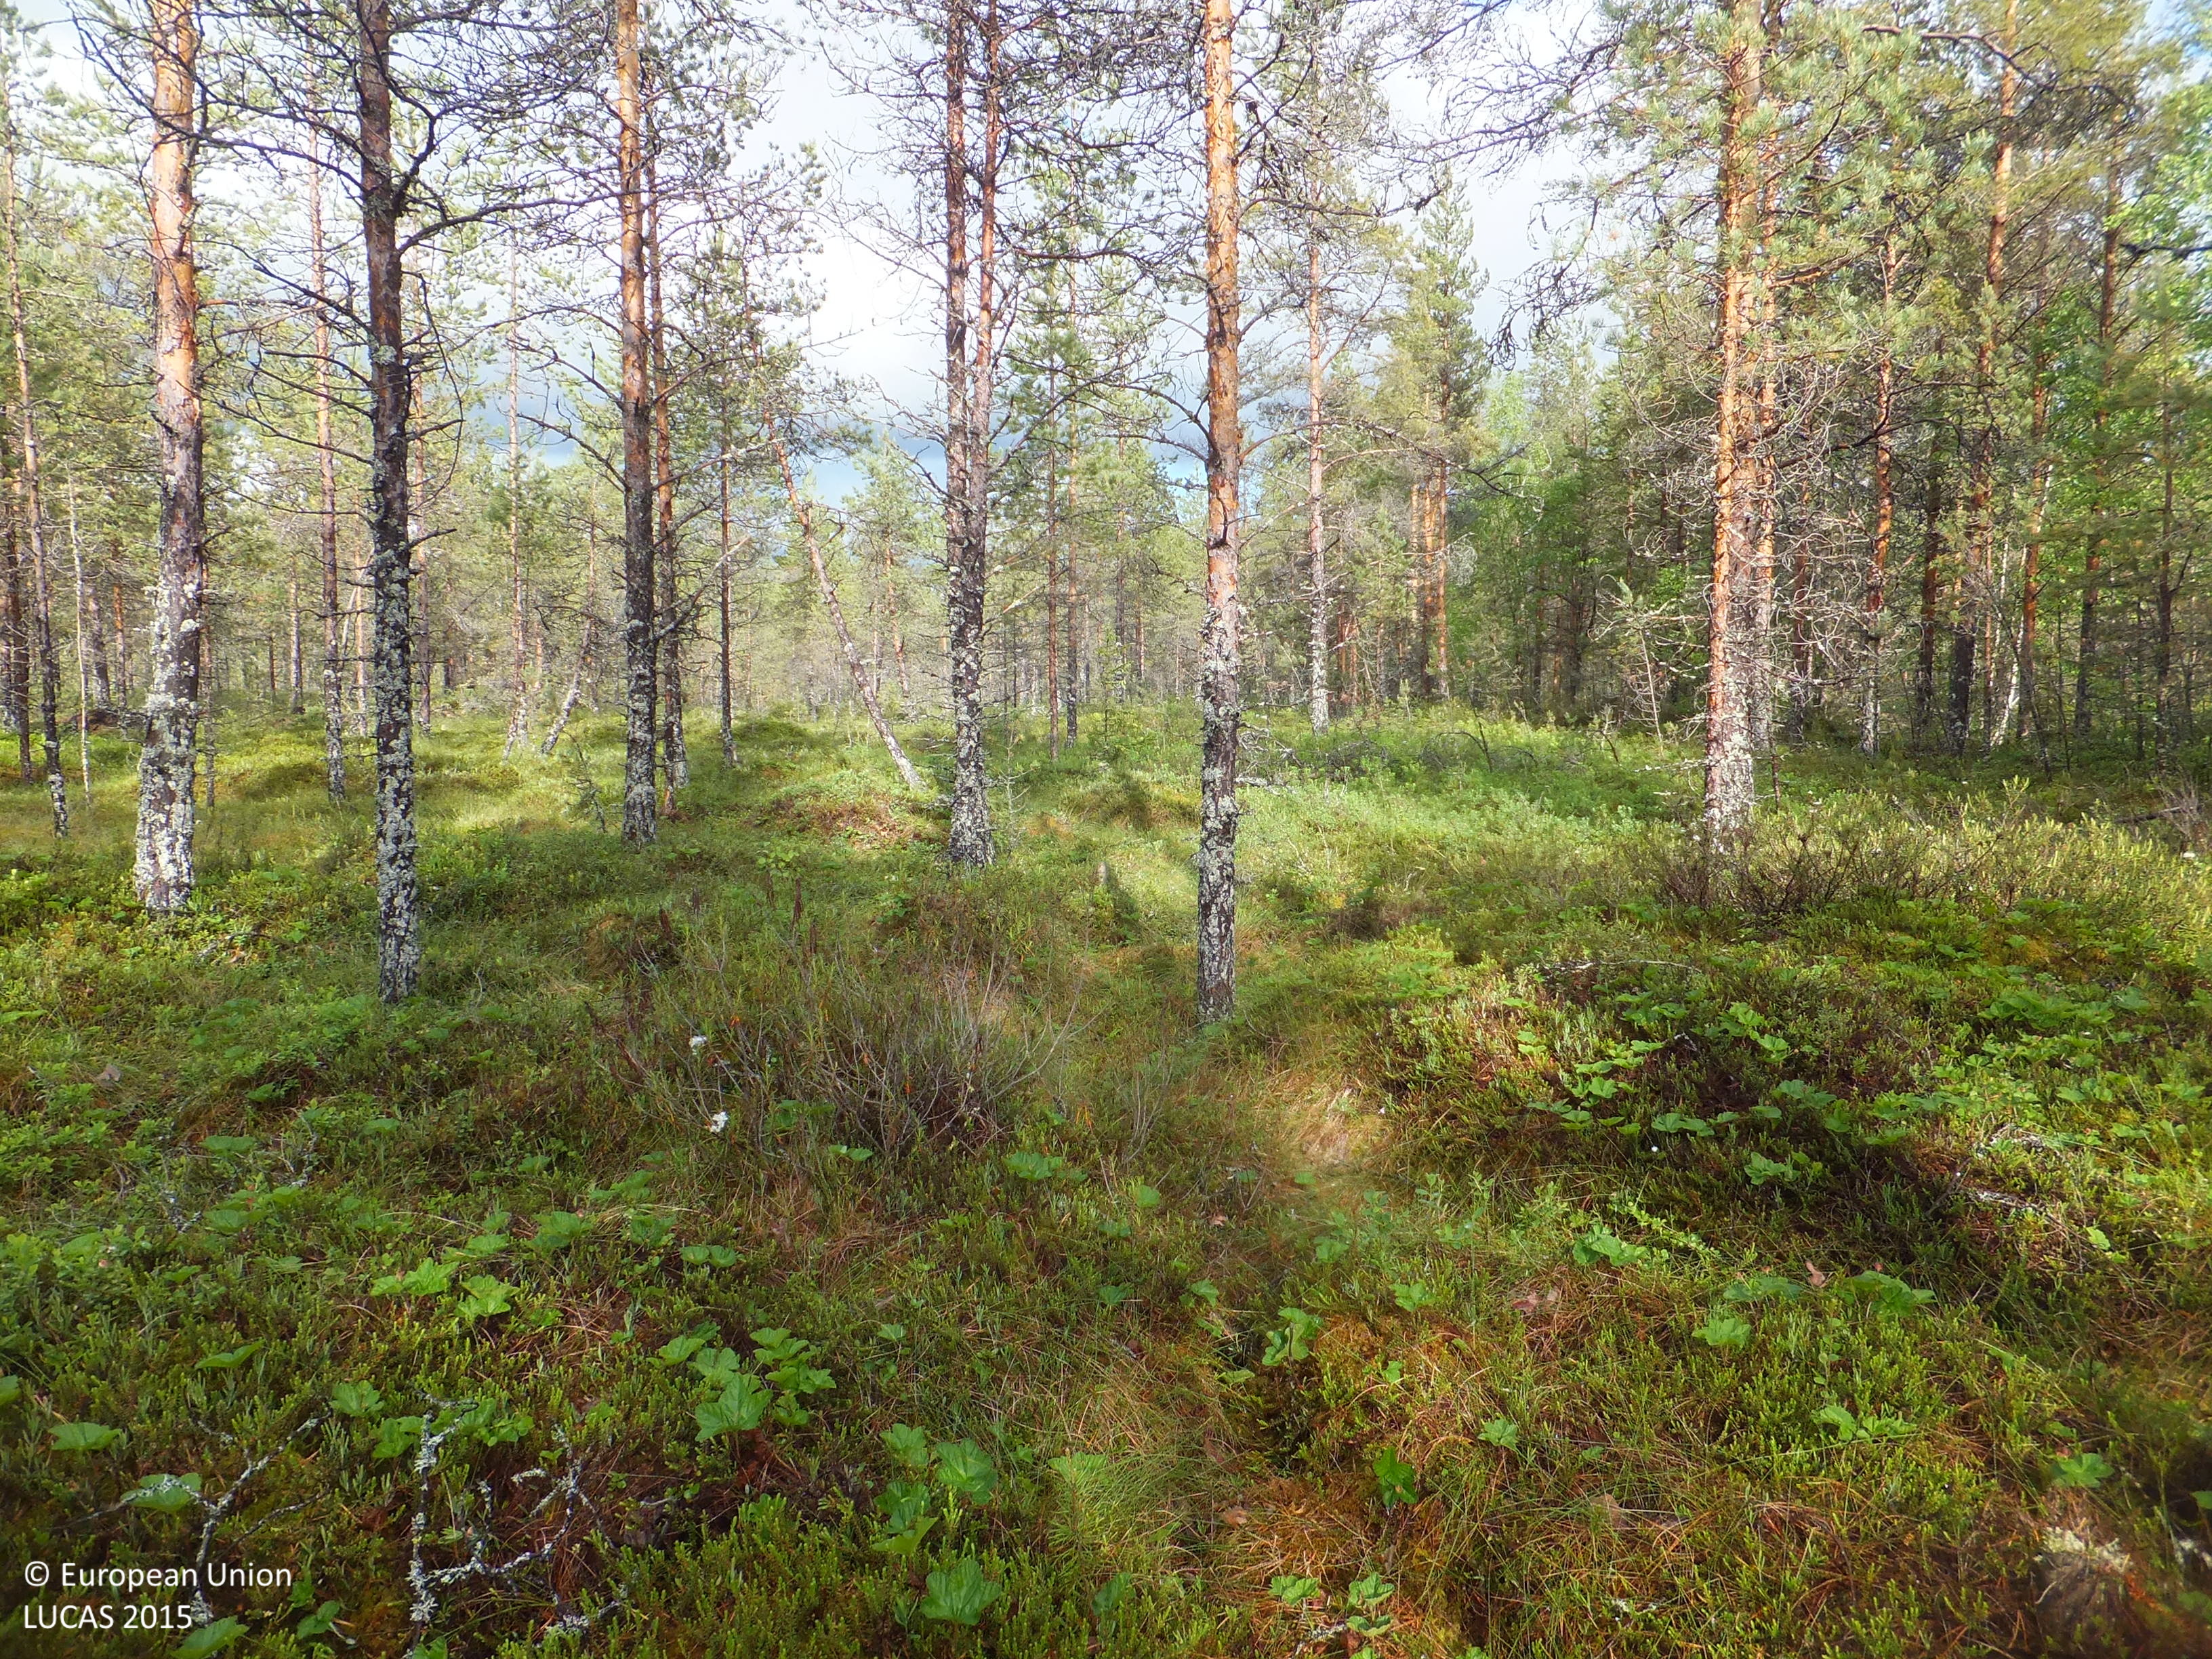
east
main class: Woodland
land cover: Pine dominated coniferous woodland
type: boreal forest
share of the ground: 50 - 75 %
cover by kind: coniferous forest trees 50 %, shrubs 20 %, lichens and mosses 20 %, herbaceous plants 10 %
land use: Forestry
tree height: > 5 m
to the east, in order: Pine dominated coniferous woodland; Shrubland with sparse tree cover; Pine dominated coniferous woodland; Ditches and canals; Pine dominated coniferous woodland; Ditches and canals; Pine dominated coniferous woodland; Ditches and canals; Groves; Tracks; Pine dominated coniferous woodland; Ditches and canals; Pine dominated coniferous woodland
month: June
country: FI
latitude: 63.4112
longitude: 24.7241
